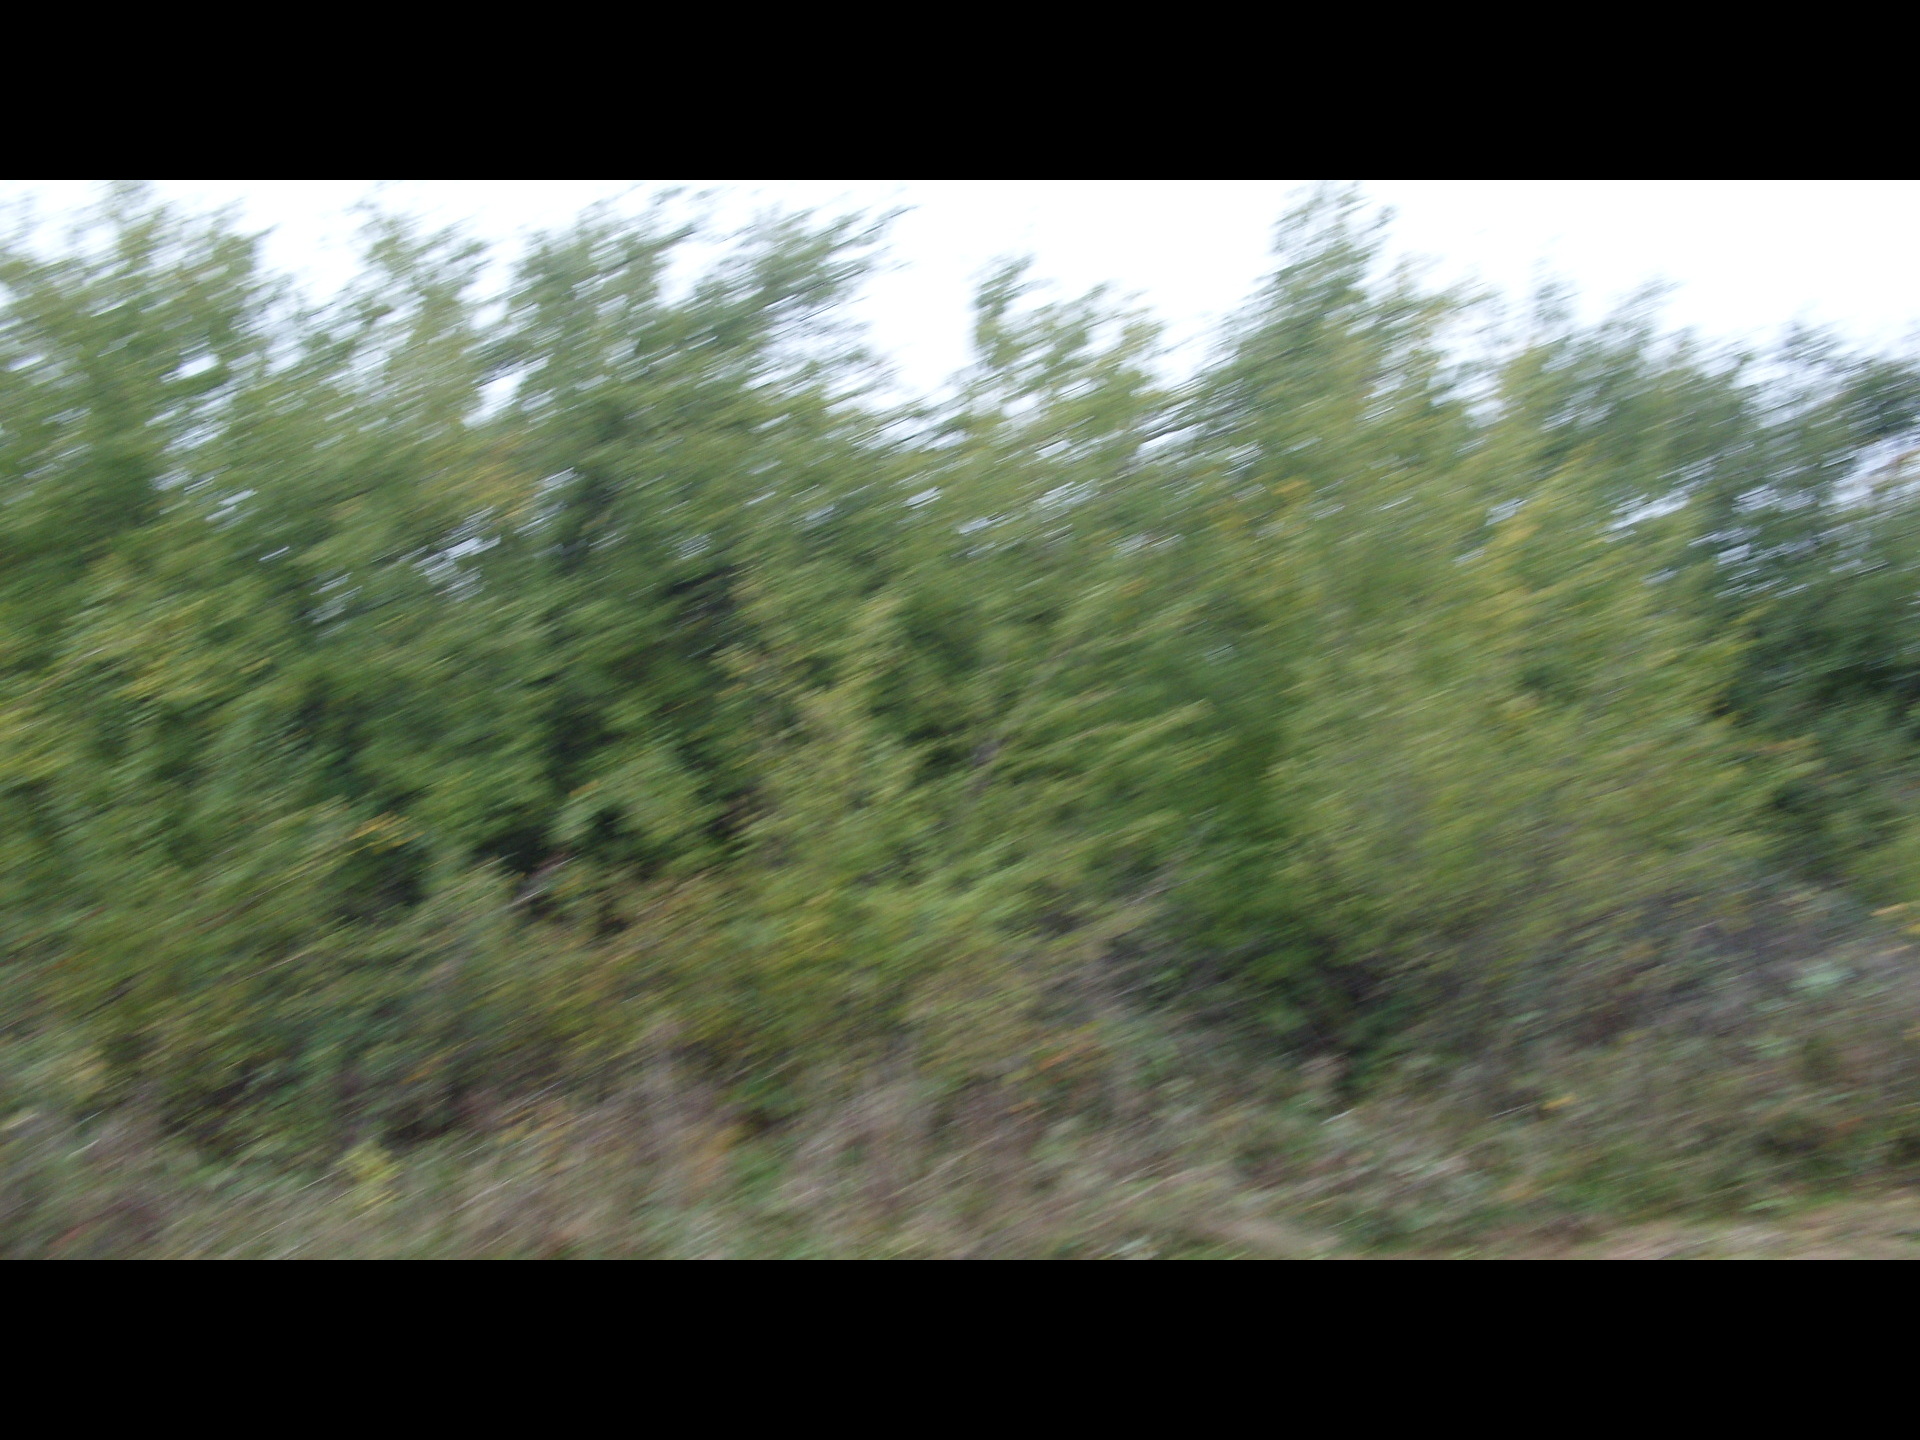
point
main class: Cropland
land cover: Pear fruit
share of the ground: 50 - 75 %
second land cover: Spontaneously vegetated surfaces
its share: > 75 %
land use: Abandoned areas
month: October
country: BG
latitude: 43.5484
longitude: 22.8460
